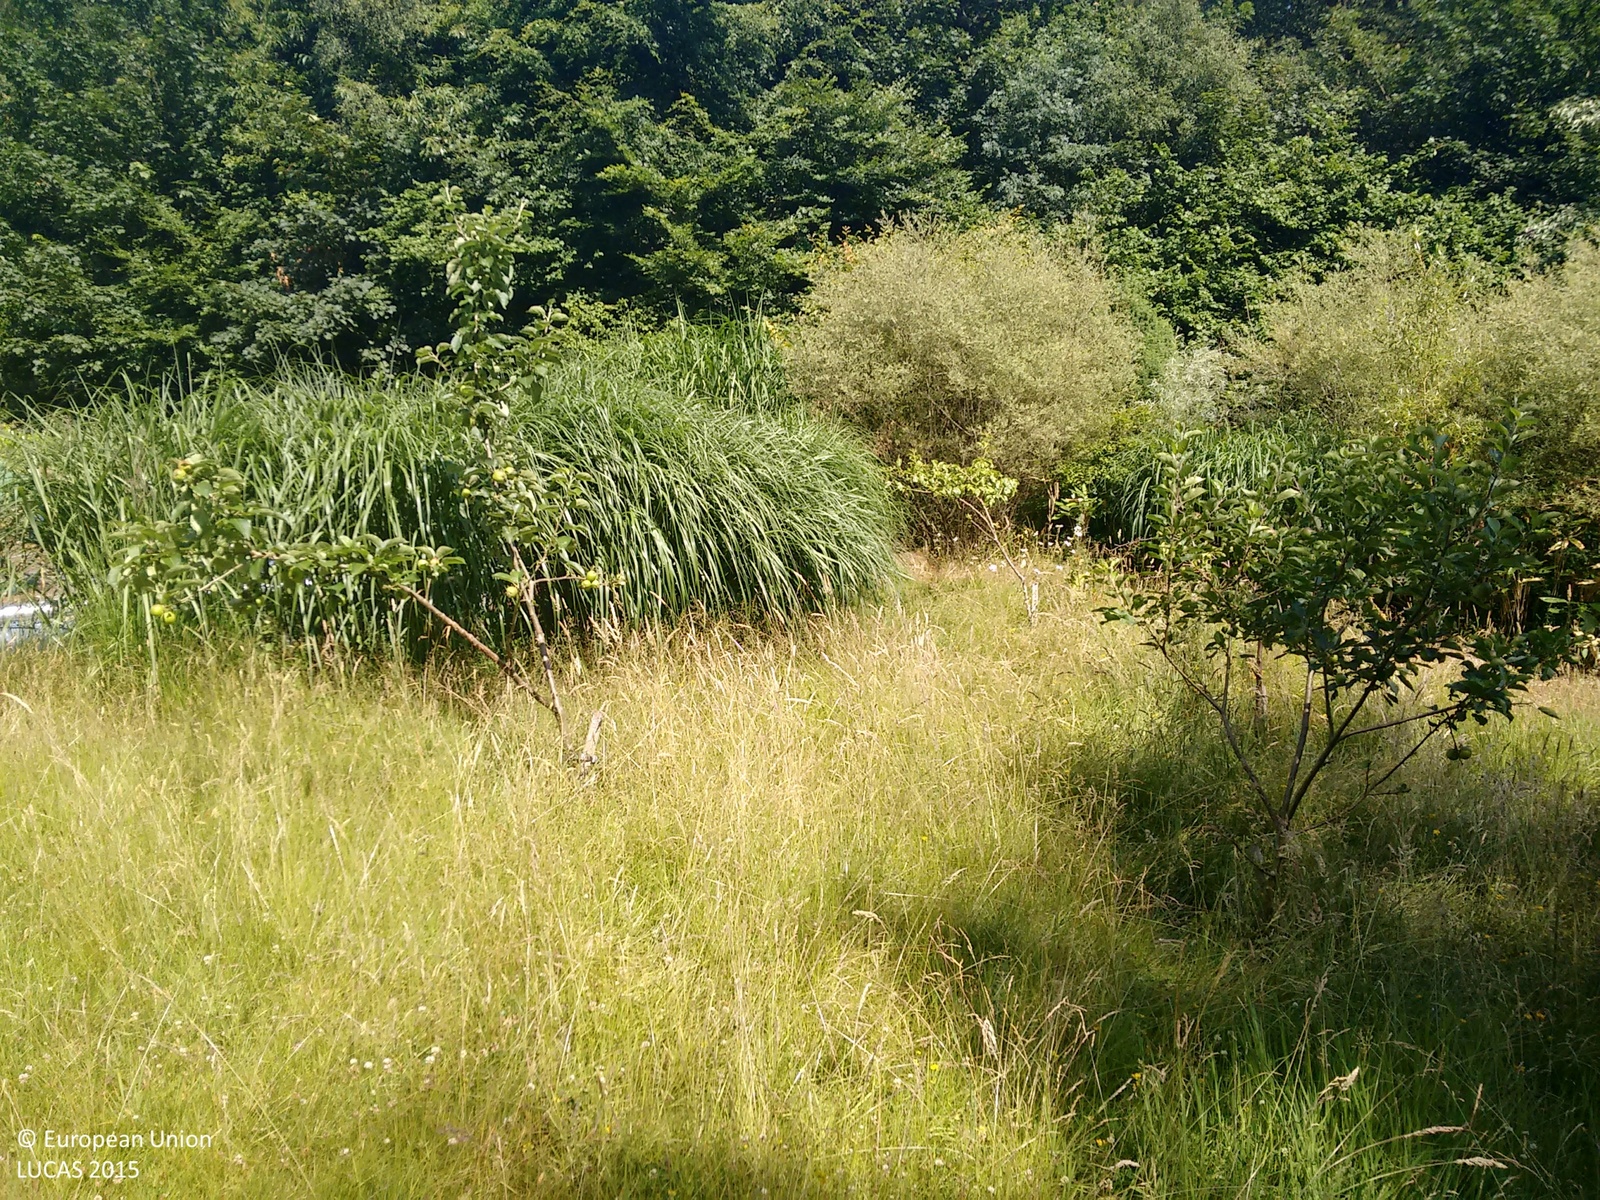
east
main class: Grassland
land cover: Grassland with sparse tree/shrub cover
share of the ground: > 75 %
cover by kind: herbaceous plants 95 %, broadleaved forest trees 5 %
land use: Residential
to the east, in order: Dry stone walls; Grassland without tree/shrub cover; Artificial constructions in urban areas; Broadleaved woodland
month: July
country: GB
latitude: 51.1702
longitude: -0.4643
